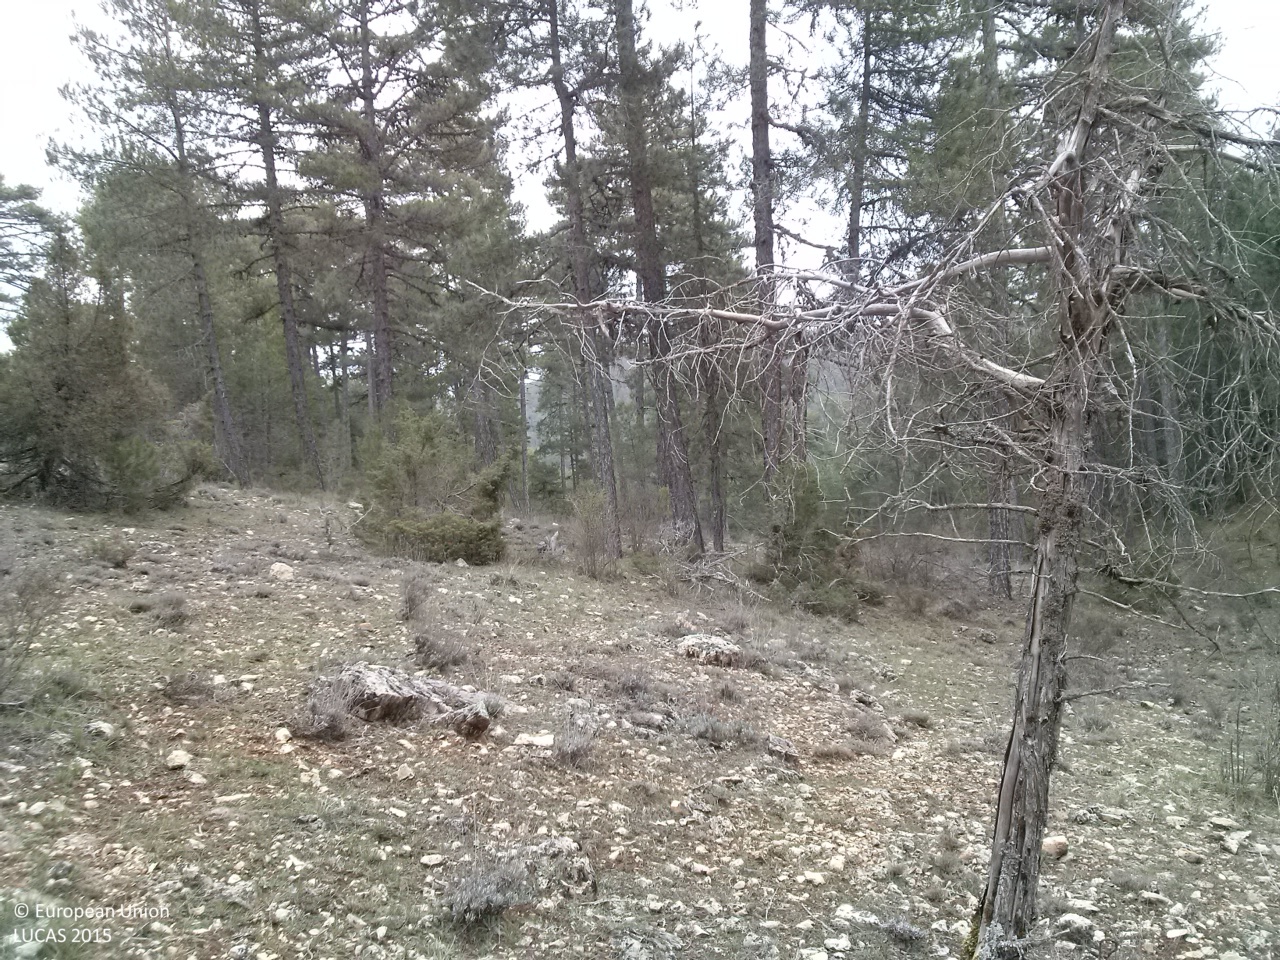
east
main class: Woodland
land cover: Pine dominated coniferous woodland
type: coniferous forest of the mediterranean region
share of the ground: 25 - 50 %
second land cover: Grassland without tree/shrub cover
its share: > 75 %
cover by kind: herbaceous plants 45 %, coniferous forest trees 25 %, consolidated bare surface 25 %, shrubs 5 %
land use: Forestry
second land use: Agriculture (excluding fallow land and kitchen gardens)
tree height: > 5 m
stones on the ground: 25 - 50 %
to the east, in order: Pine dominated coniferous woodland; Grassland without tree/shrub cover; Rock outcrops; Other coniferous woodland
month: April
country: ES
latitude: 40.3182
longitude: -1.9617
